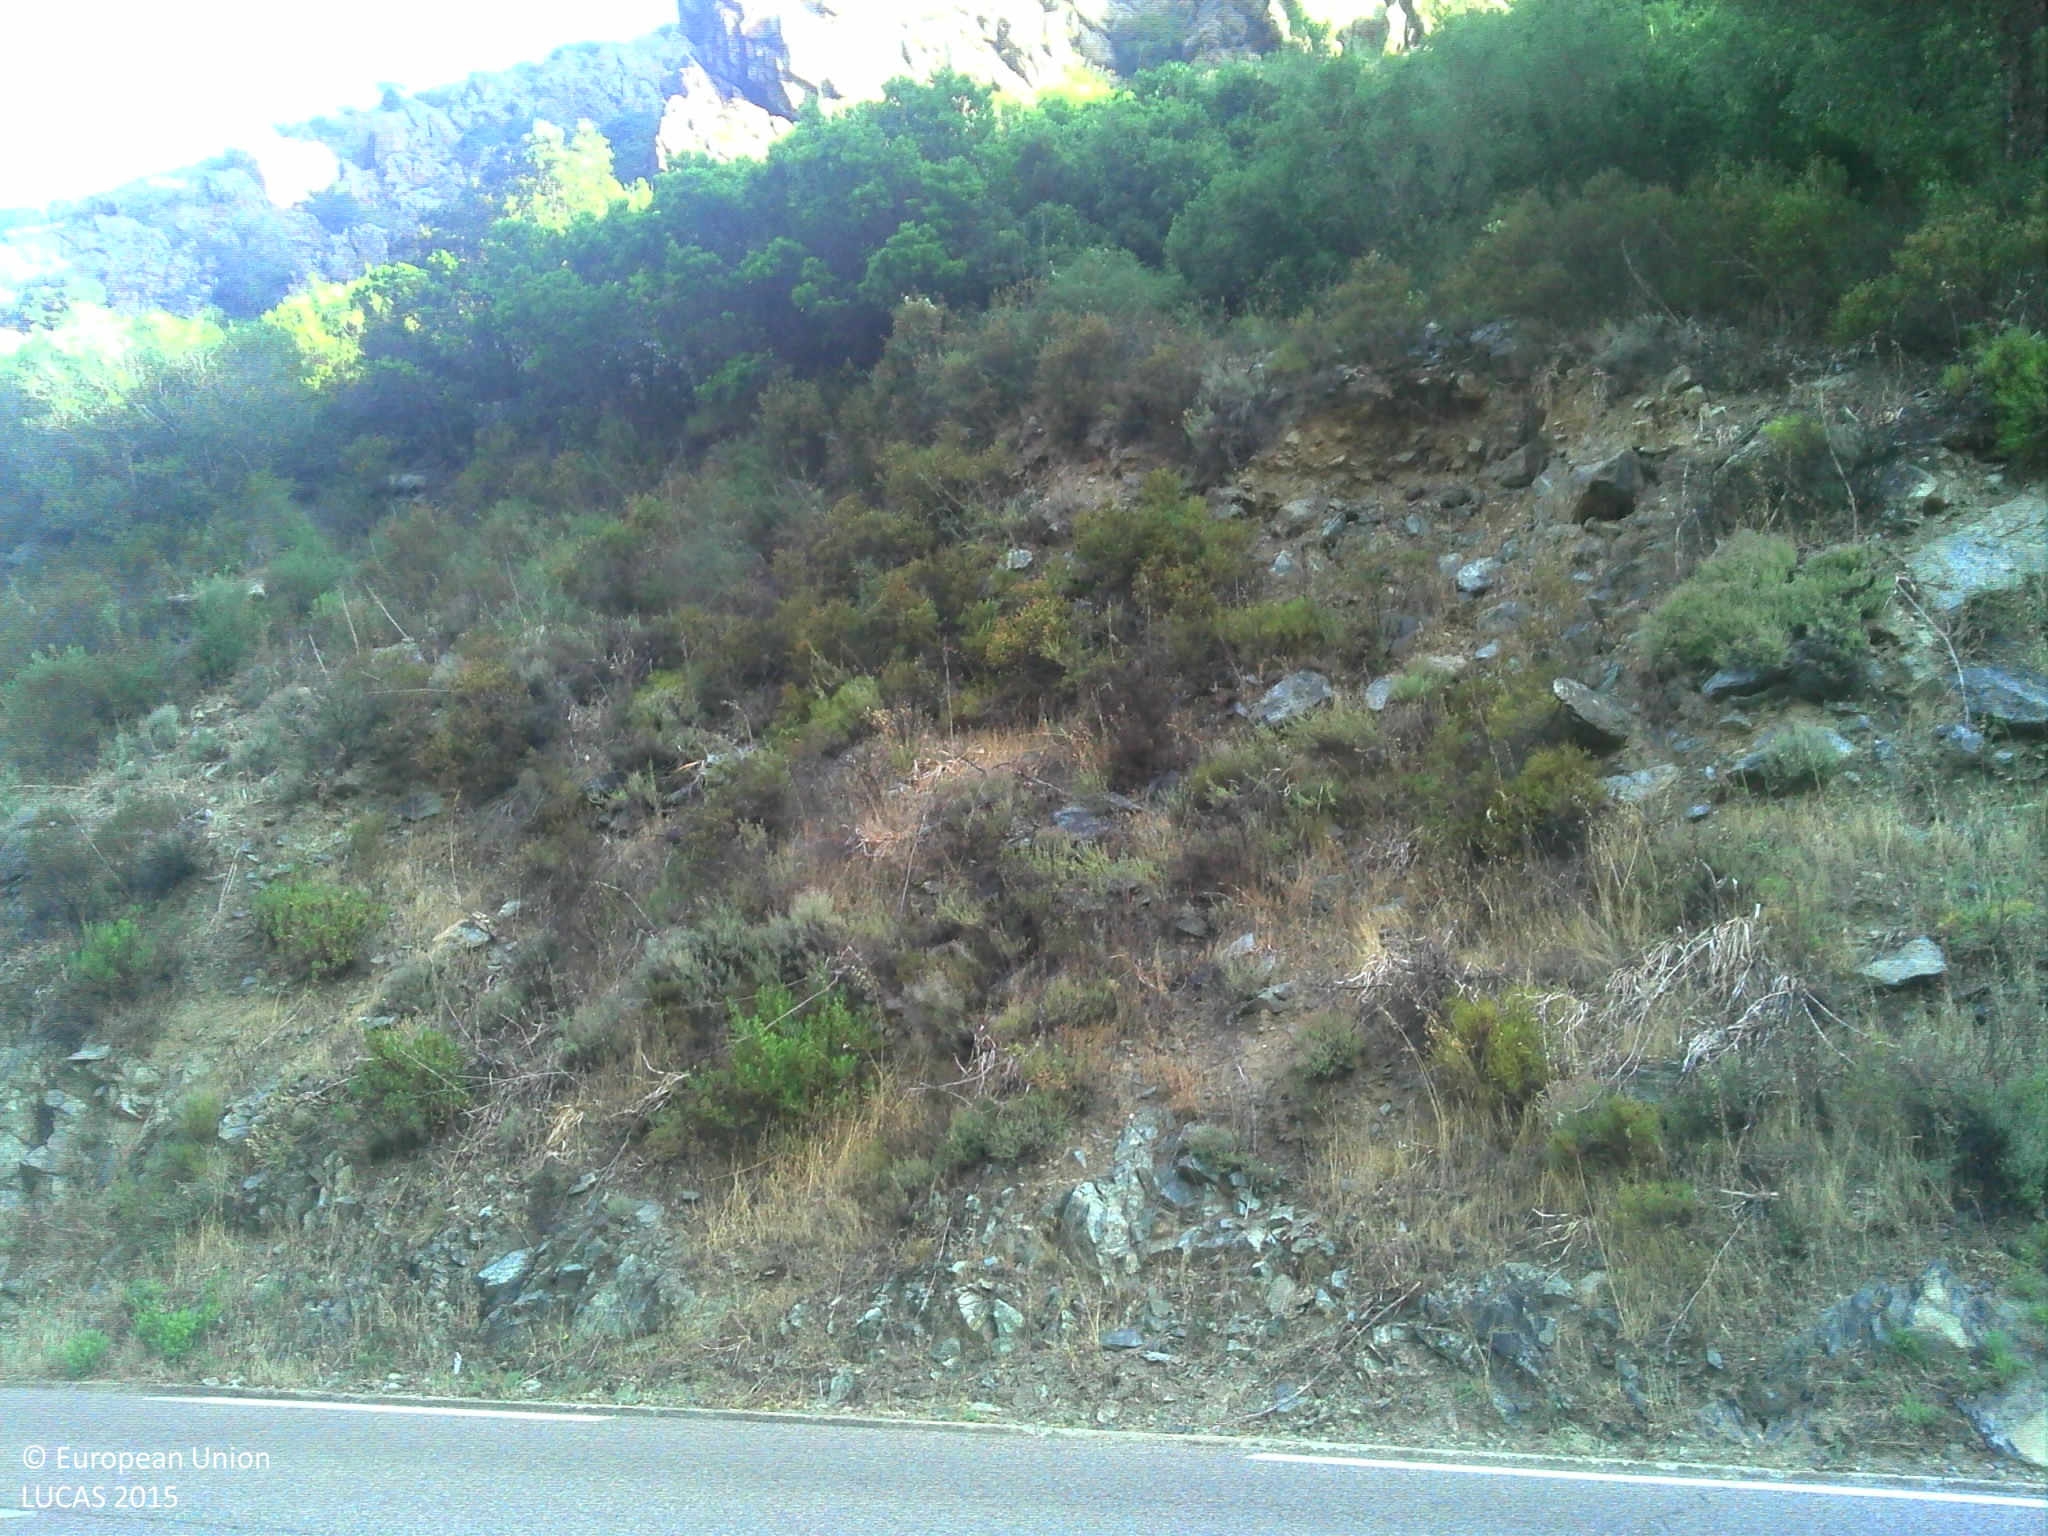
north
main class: Shrubland
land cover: Shrubland without tree cover
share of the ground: > 75 %
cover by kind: shrubs 80 %, consolidated bare surface 20 %
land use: Semi-natural and natural areas not in use
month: July
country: FR
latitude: 42.5073
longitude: 9.3330
